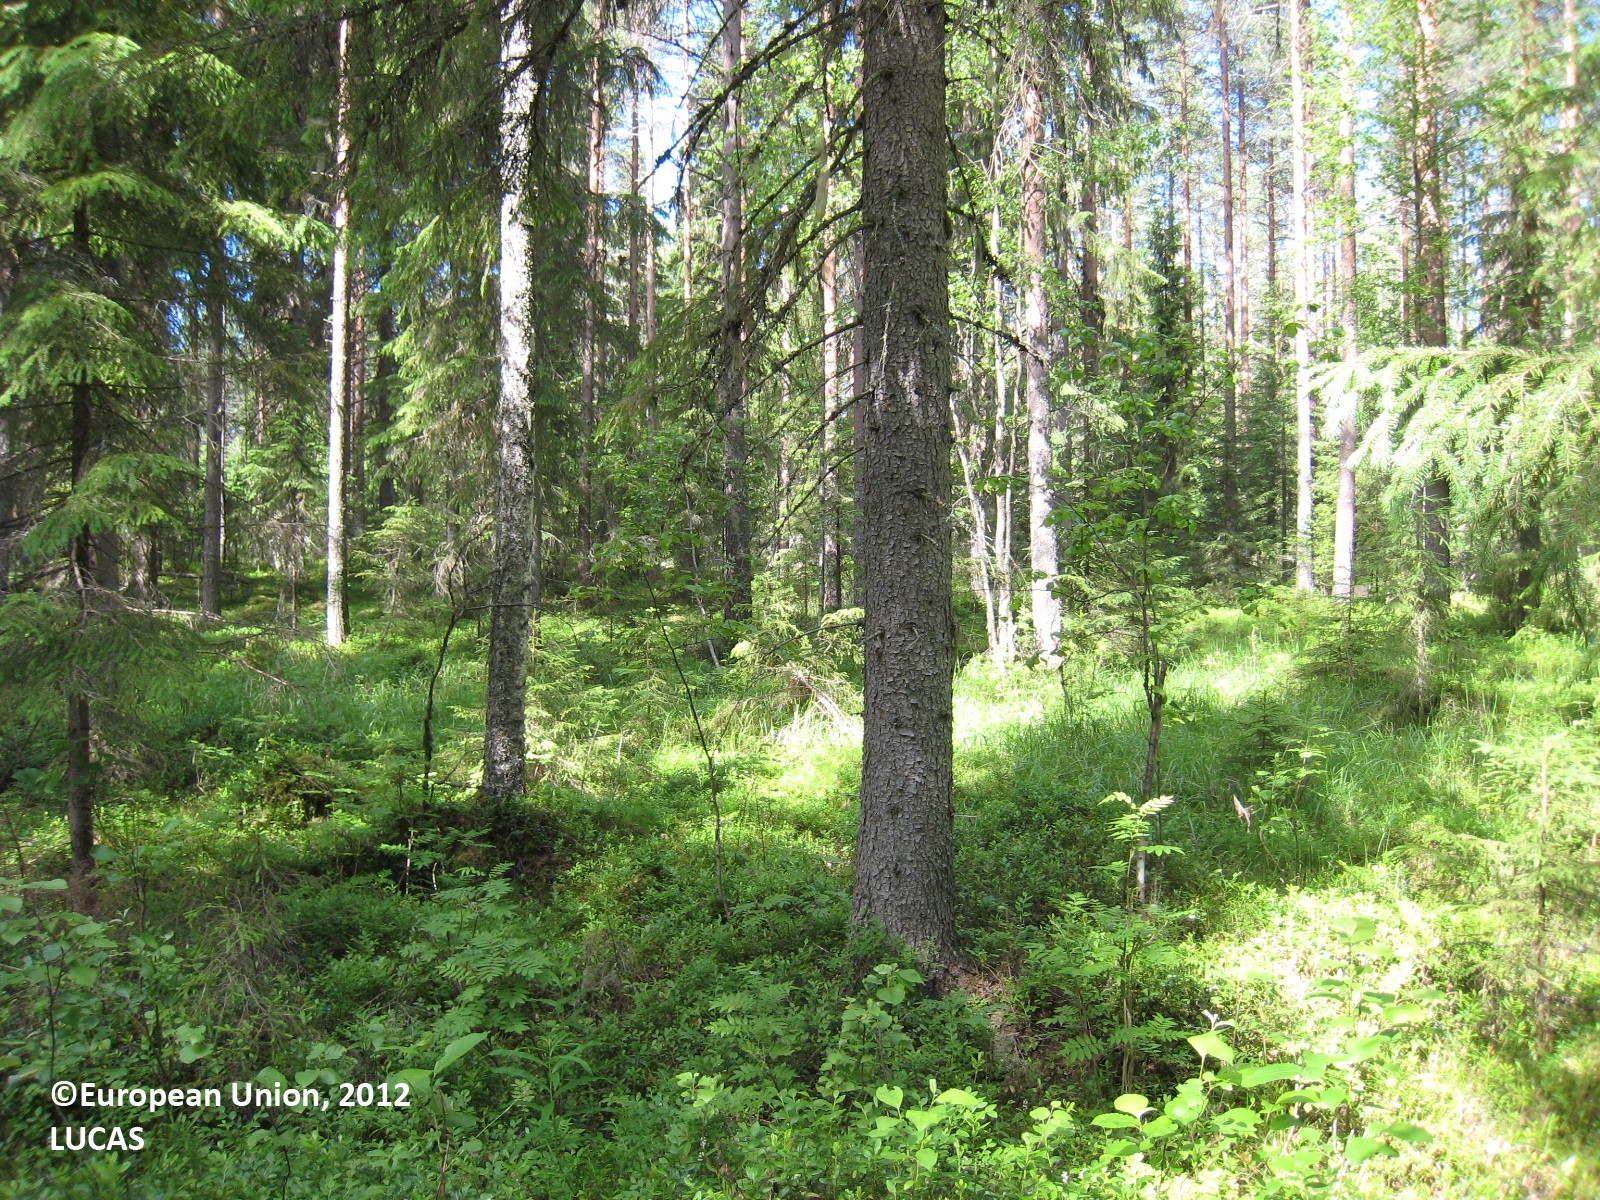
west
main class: Woodland
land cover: Spruce dominated coniferous woodland
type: boreal forest
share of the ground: 50 - 75 %
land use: Forestry
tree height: > 5 m
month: July
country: FI
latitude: 63.1970
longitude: 25.7545
